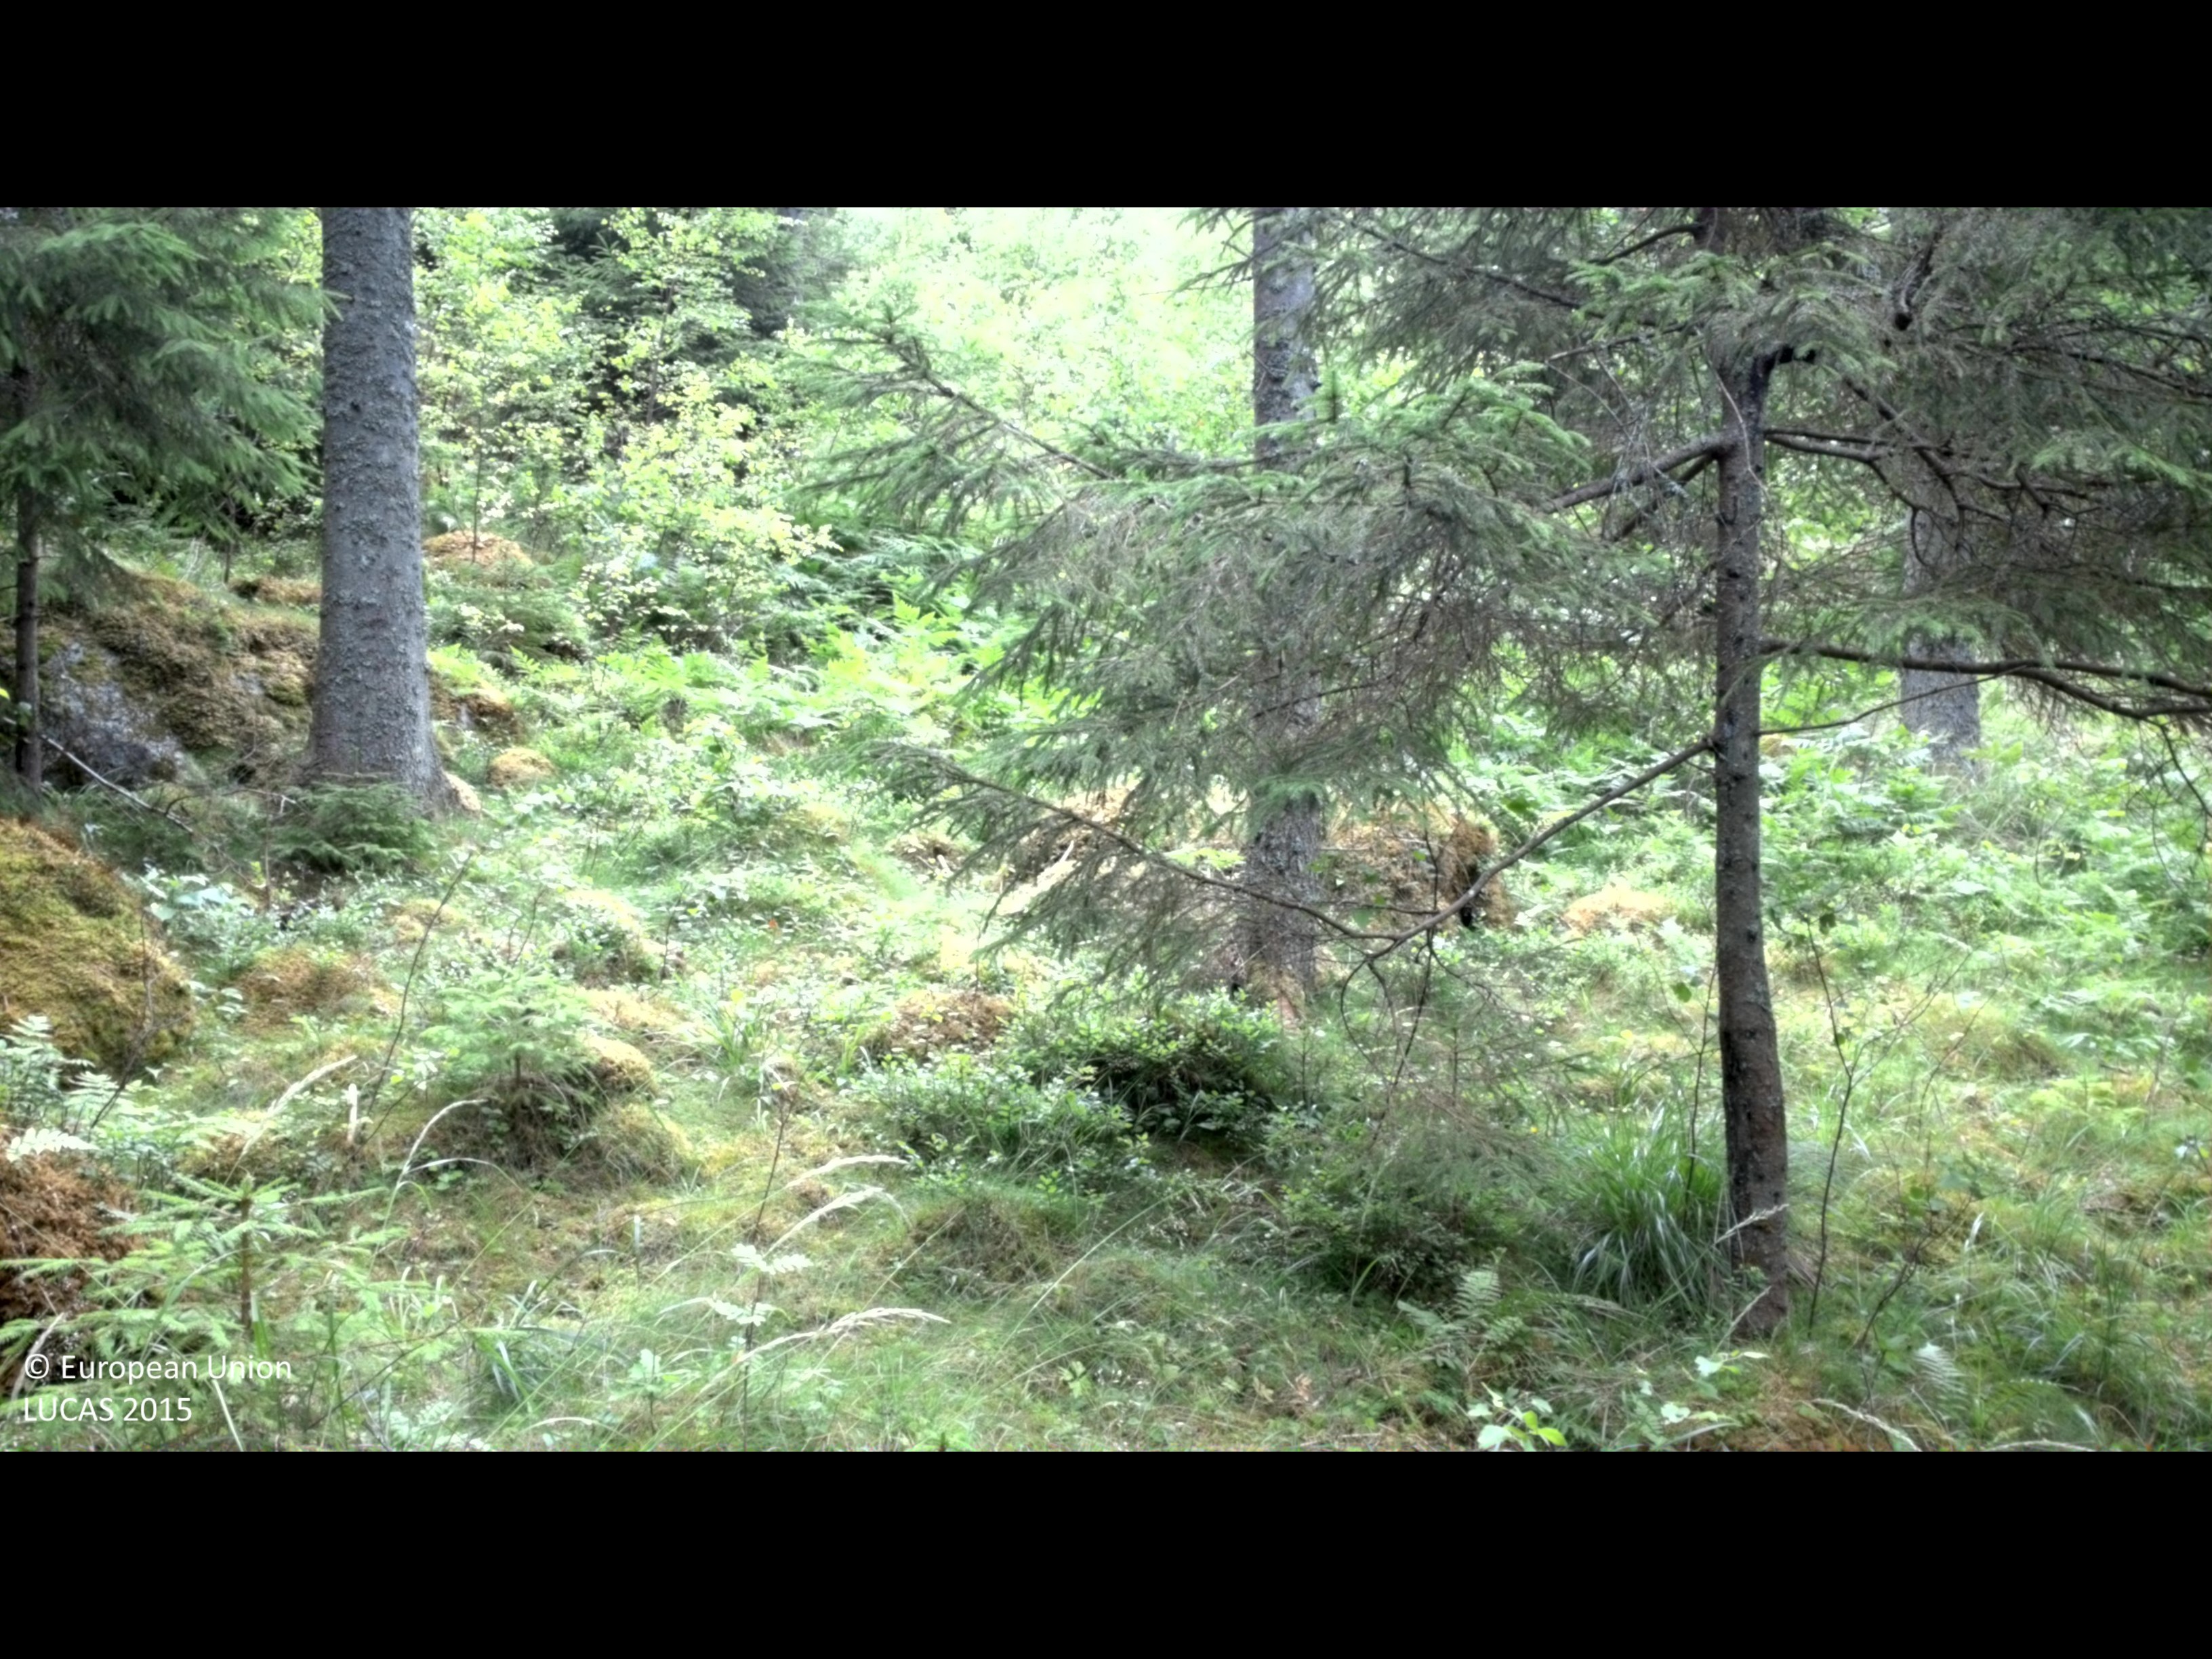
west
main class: Woodland
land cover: Spruce dominated coniferous woodland
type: boreal forest
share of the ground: 50 - 75 %
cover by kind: coniferous forest trees 55 %, shrubs 25 %, herbaceous plants 10 %, broadleaved forest trees 5 %, lichens and mosses 5 %
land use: Forestry
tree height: > 5 m
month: July
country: SE
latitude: 58.1277
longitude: 16.2622
